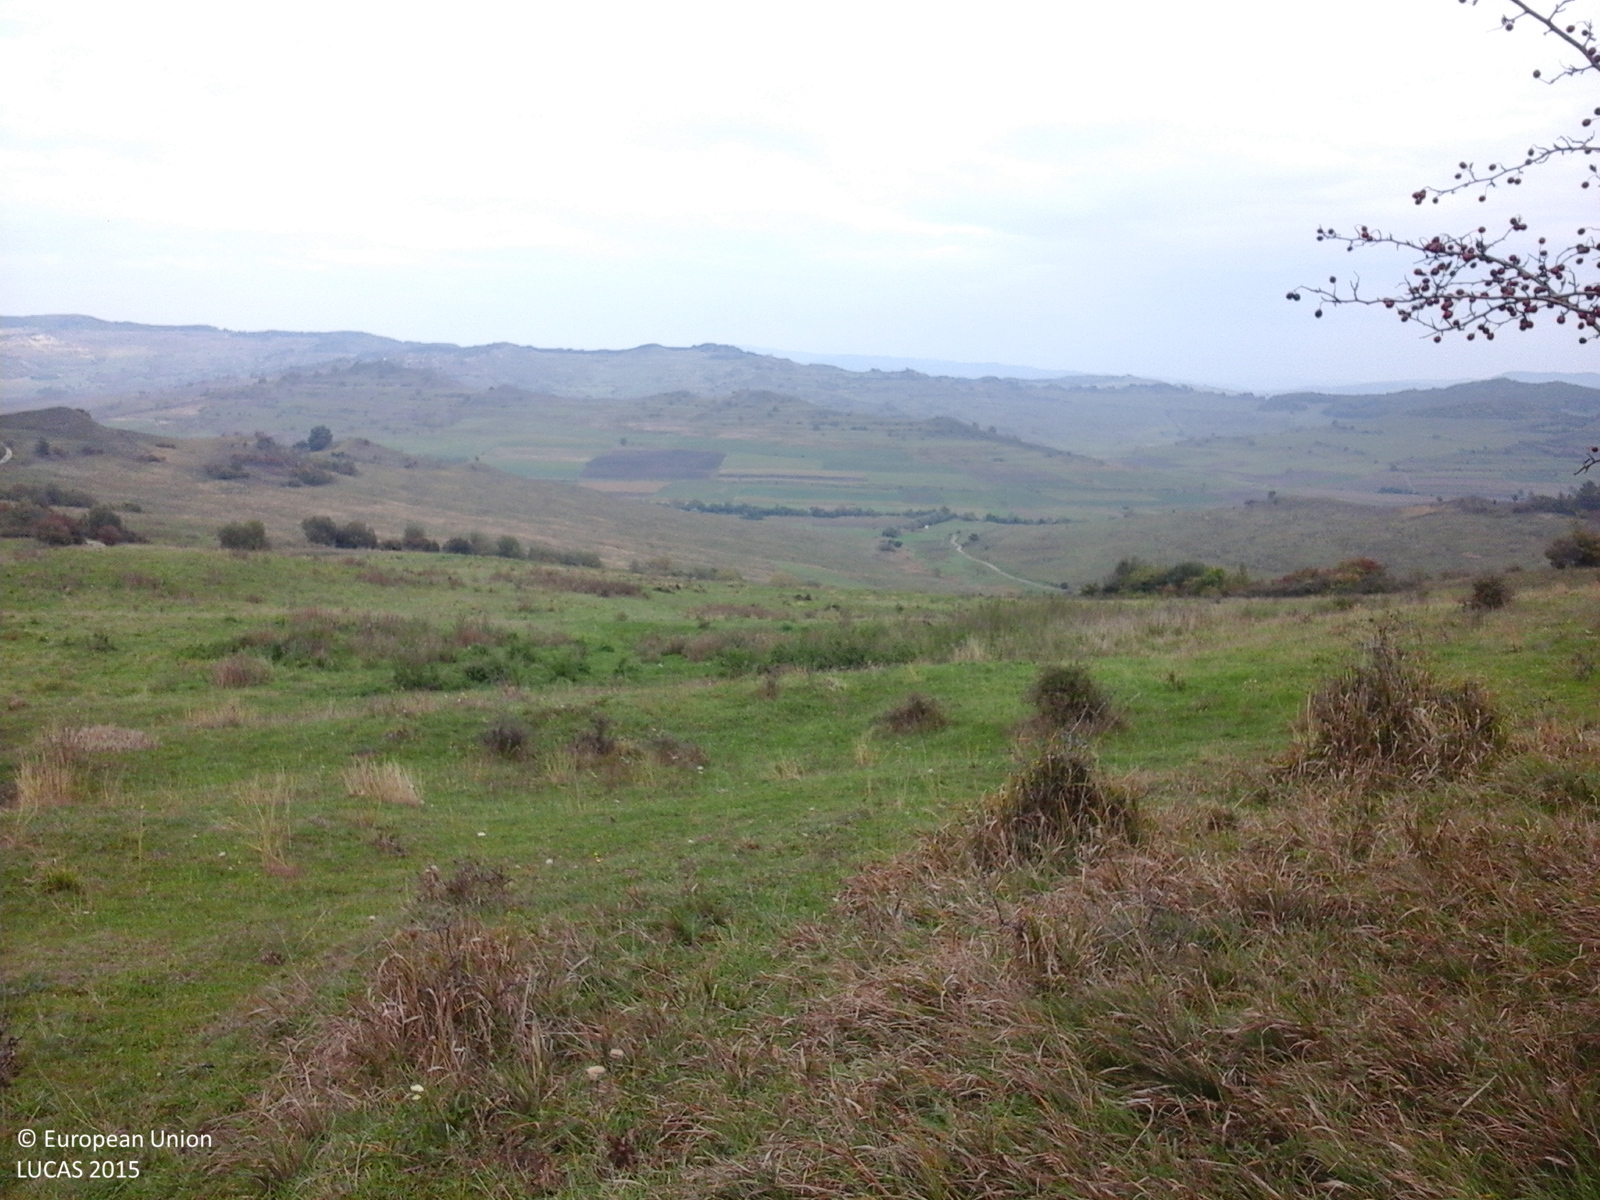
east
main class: Grassland
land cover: Grassland with sparse tree/shrub cover
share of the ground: > 75 %
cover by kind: herbaceous plants 85 %, shrubs 10 %, broadleaved forest trees 5 %
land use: Agriculture (excluding fallow land and kitchen gardens)
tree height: < 5 m
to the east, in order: Grassland with sparse tree/shrub cover; Spontaneously vegetated surfaces; Grassland without tree/shrub cover
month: October
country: RO
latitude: 46.3057
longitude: 24.9089
